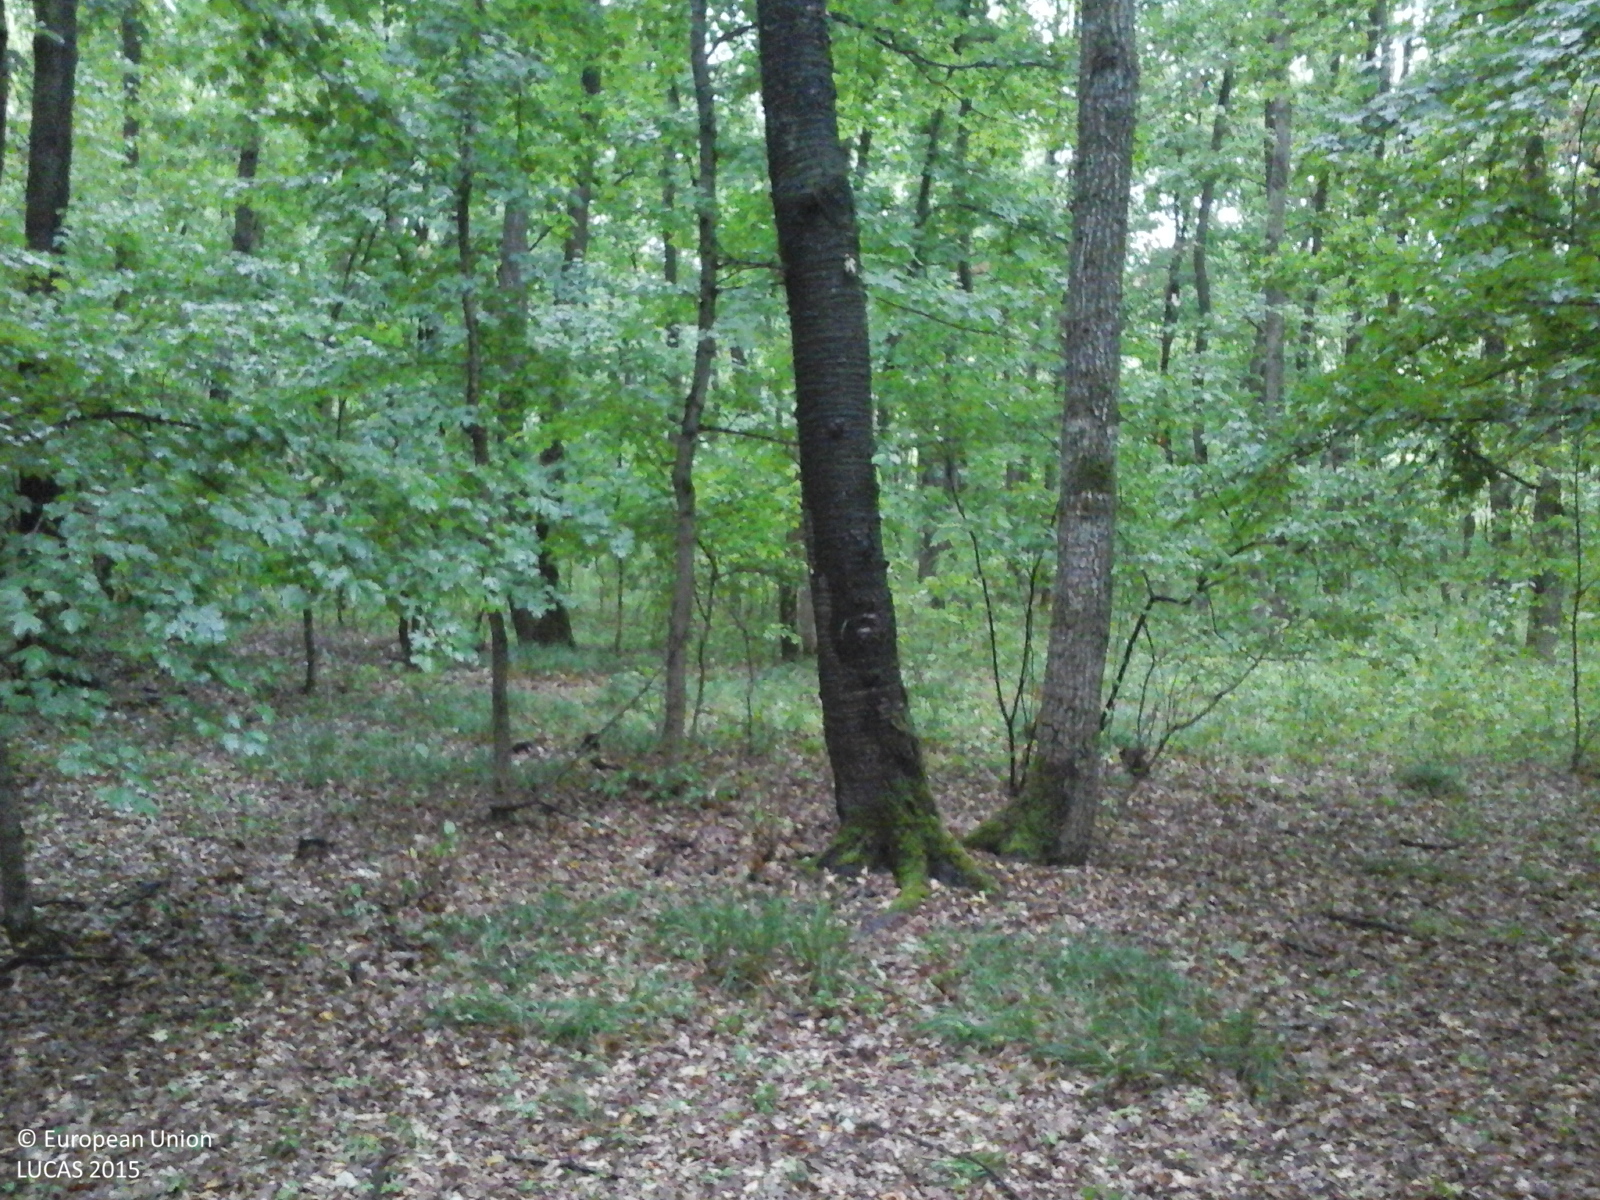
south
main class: Woodland
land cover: Broadleaved woodland
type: beech forest
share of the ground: > 75 %
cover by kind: broadleaved forest trees 95 %, herbaceous plants 5 %
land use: Forestry
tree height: > 5 m
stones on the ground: < 10 %
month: June
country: RO
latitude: 47.7616
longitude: 26.9538
